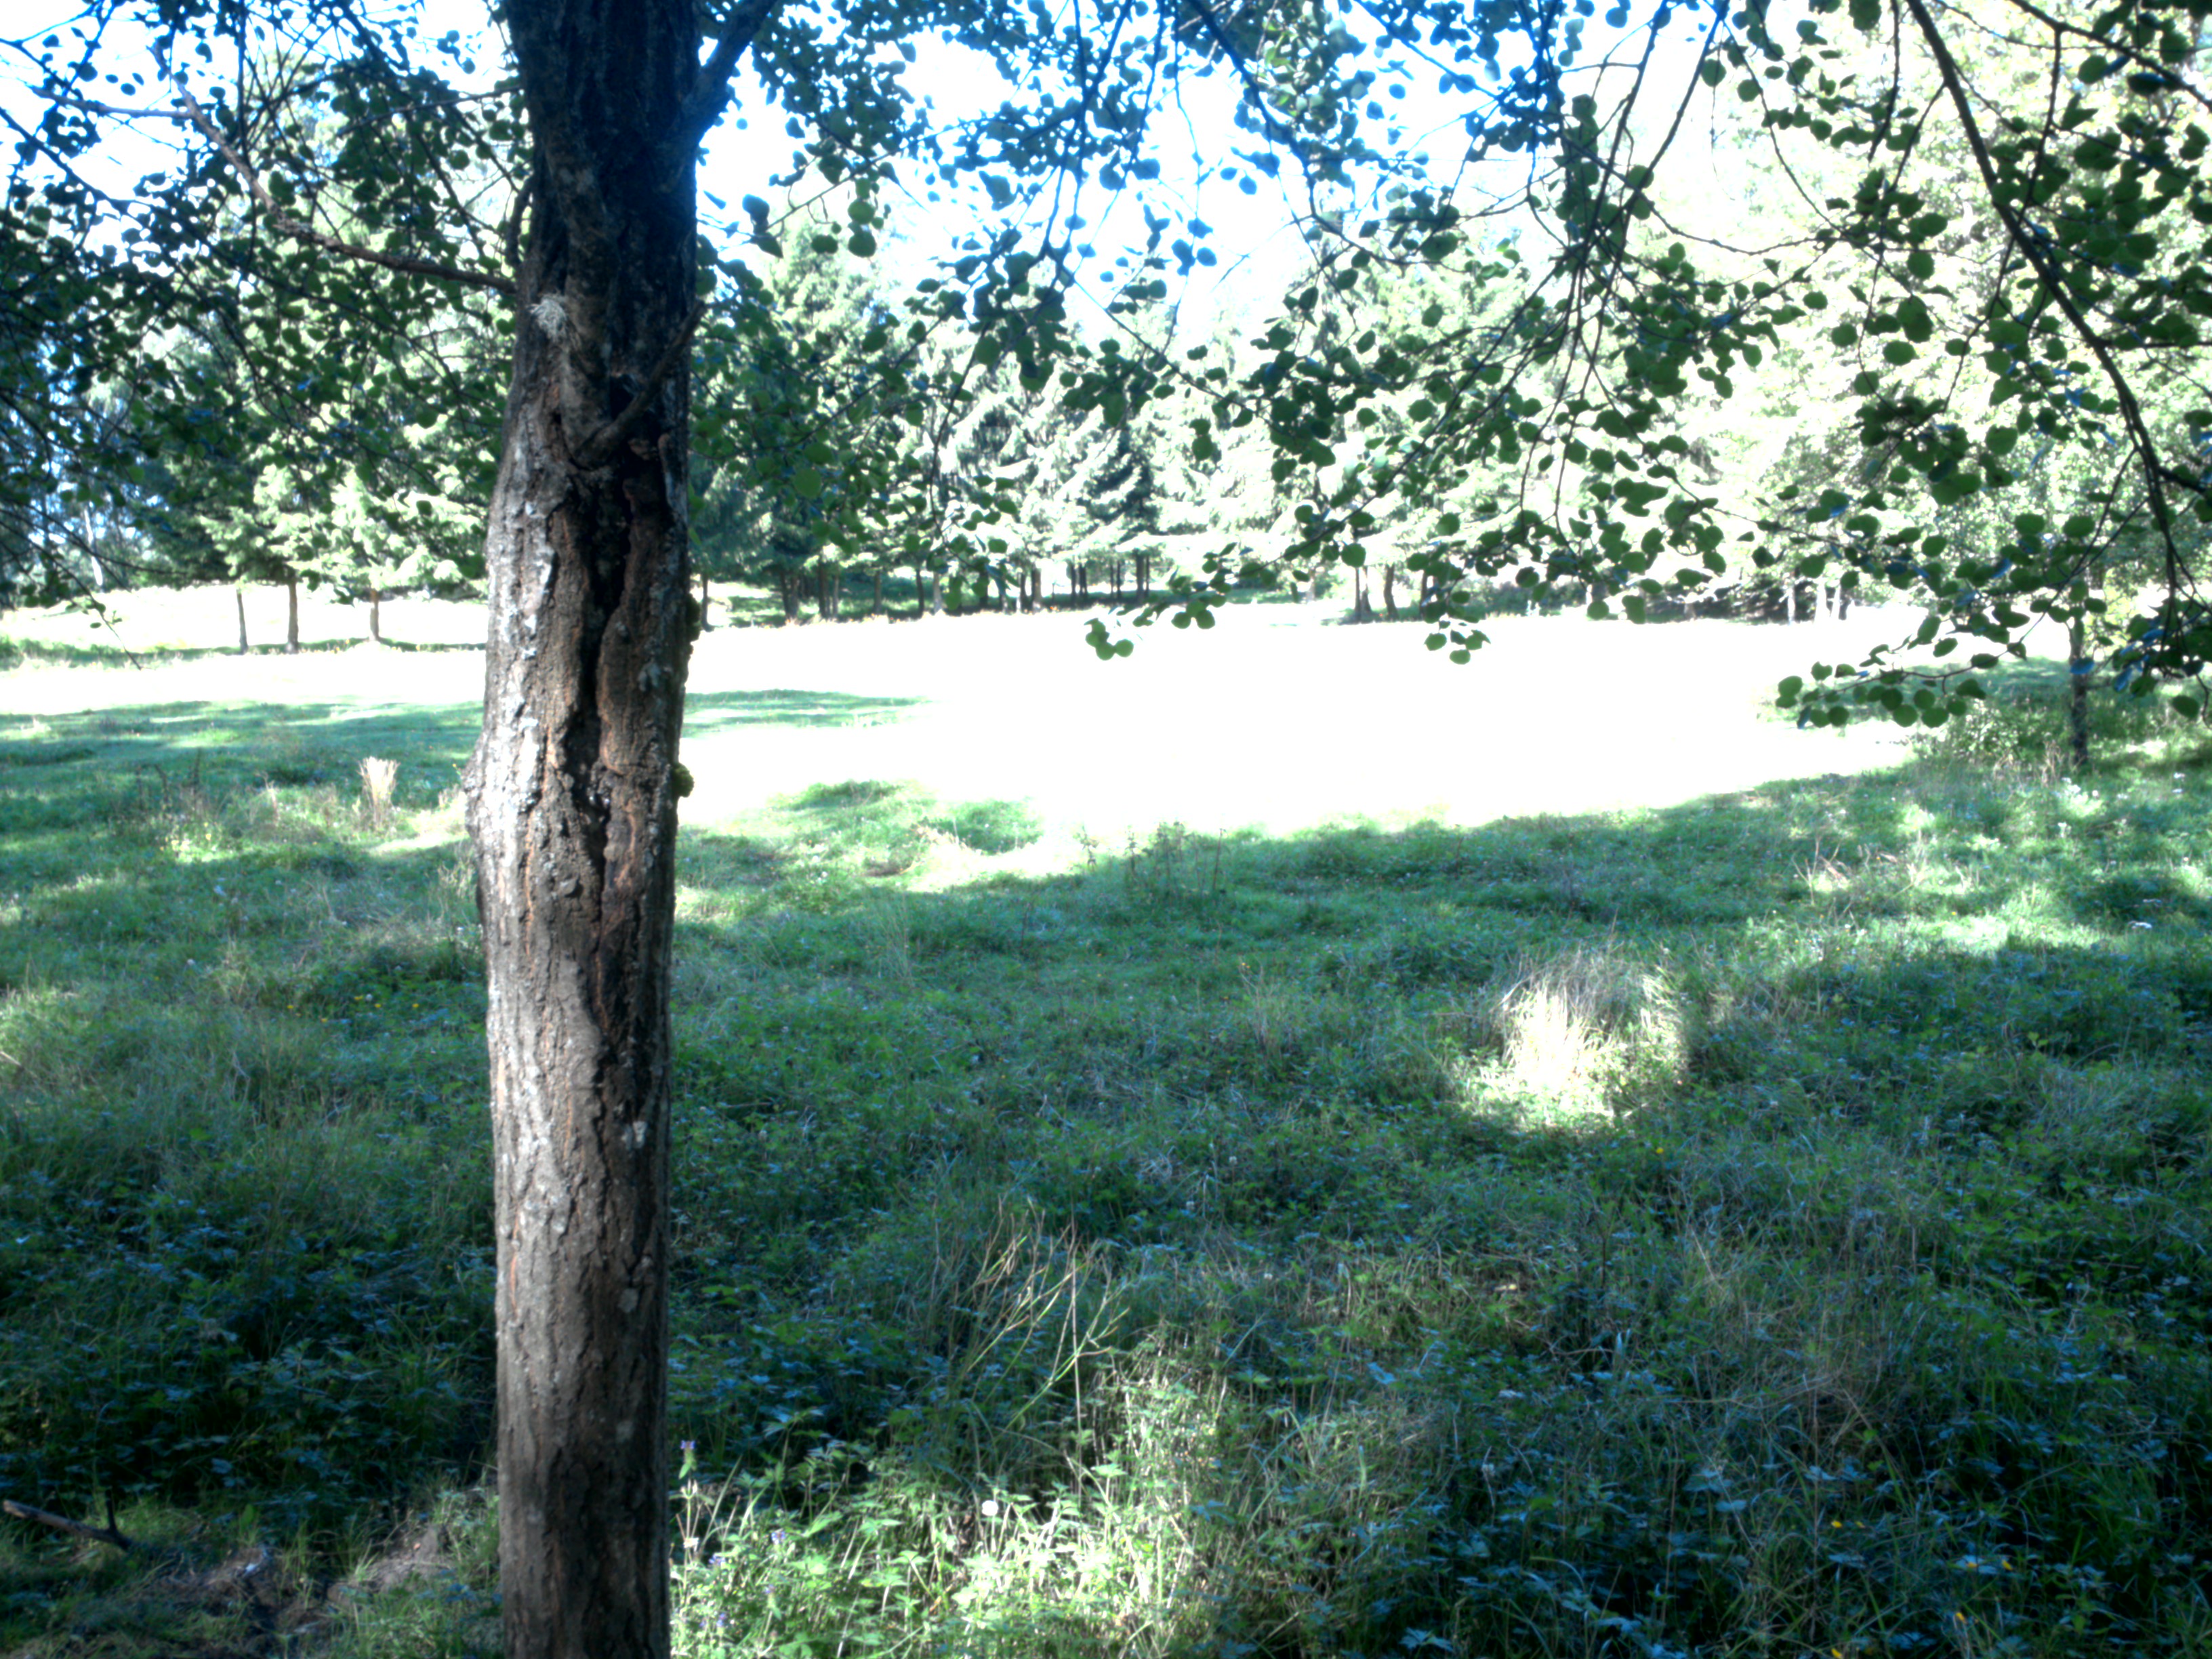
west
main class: Woodland
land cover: Broadleaved woodland
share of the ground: 50 - 75 %
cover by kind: herbaceous plants 50 %, broadleaved forest trees 40 %, coniferous forest trees 10 %
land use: Agriculture (excluding fallow land and kitchen gardens)
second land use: Forestry
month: August
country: SE
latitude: 59.1714
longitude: 17.7479
